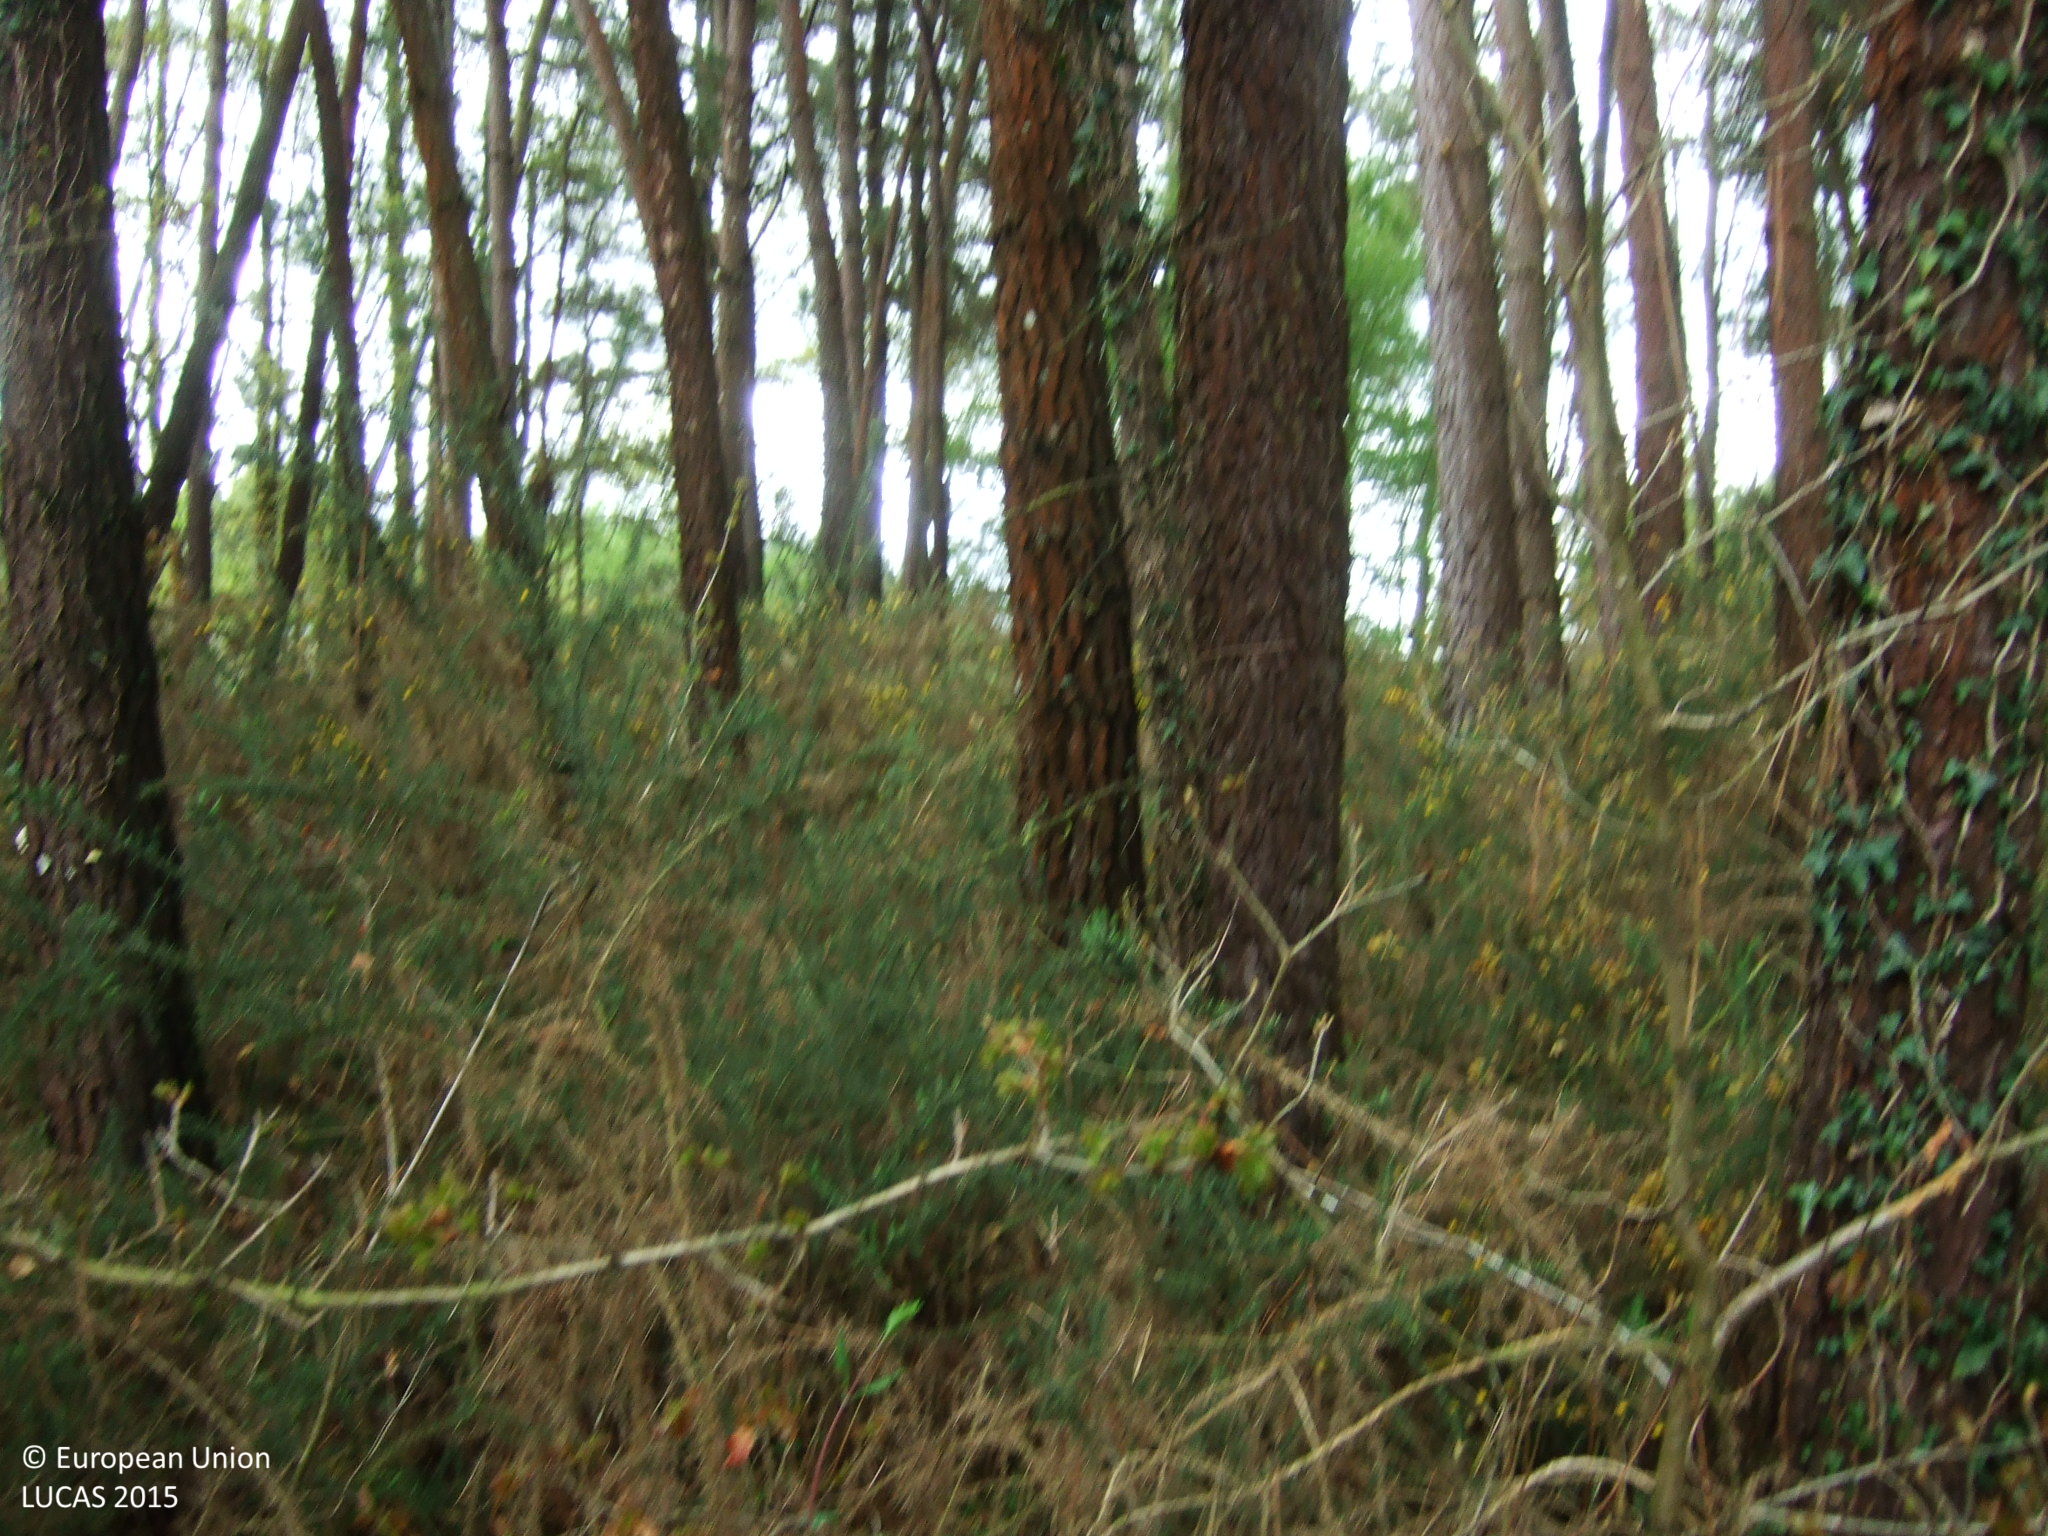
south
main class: Woodland
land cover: Pine dominated coniferous woodland
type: exotic forest
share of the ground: 25 - 50 %
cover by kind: coniferous forest trees 50 %, shrubs 50 %
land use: Forestry
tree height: > 5 m
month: April
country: ES
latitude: 42.9381
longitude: -7.4124
